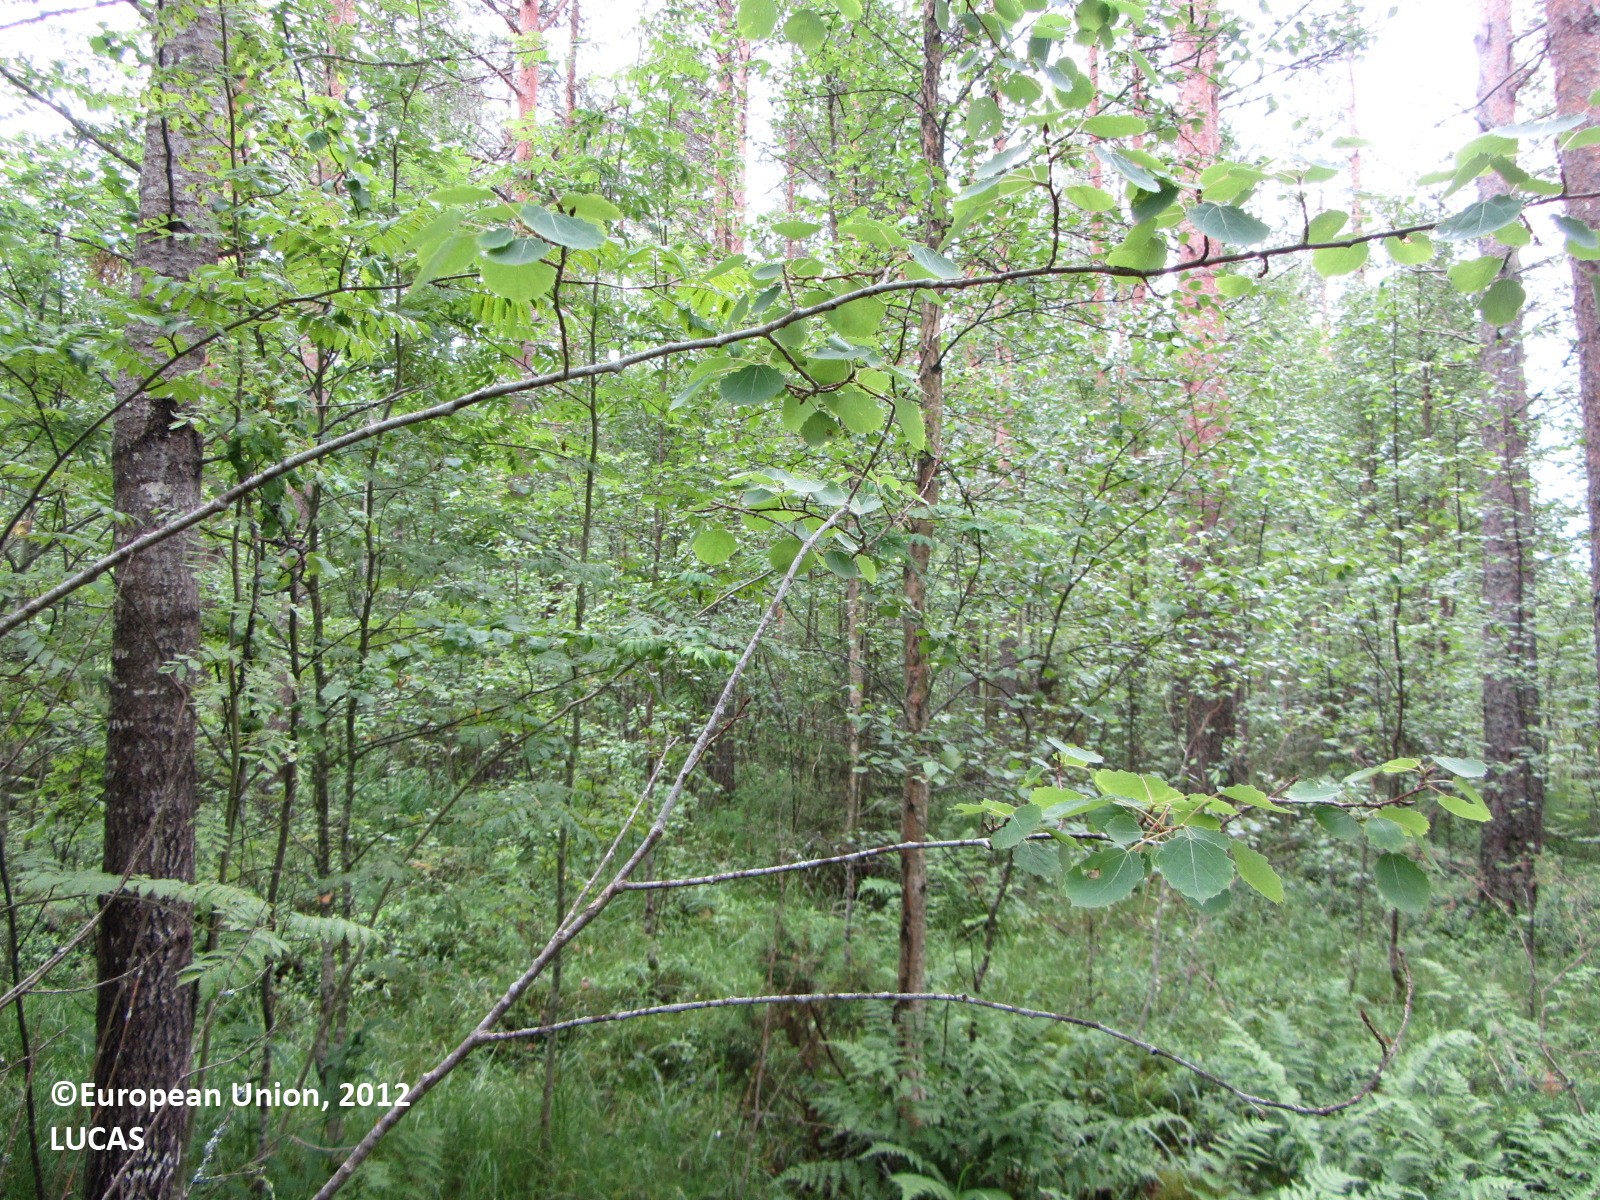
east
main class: Woodland
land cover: Pine dominated mixed woodland
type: boreal forest
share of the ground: > 75 %
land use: Forestry
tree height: > 5 m
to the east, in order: Pine dominated mixed woodland; Ditches and canals; Temporary grasslands; Ditches and canals; Pine dominated mixed woodland; Broadleaved woodland; Rivers and streams; Other mixed woodland; Pine dominated coniferous woodland; Ditches and canals; Pine dominated mixed woodland; Ditches and canals; Broadleaved woodland
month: July
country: FI
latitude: 63.7391
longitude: 25.5149
